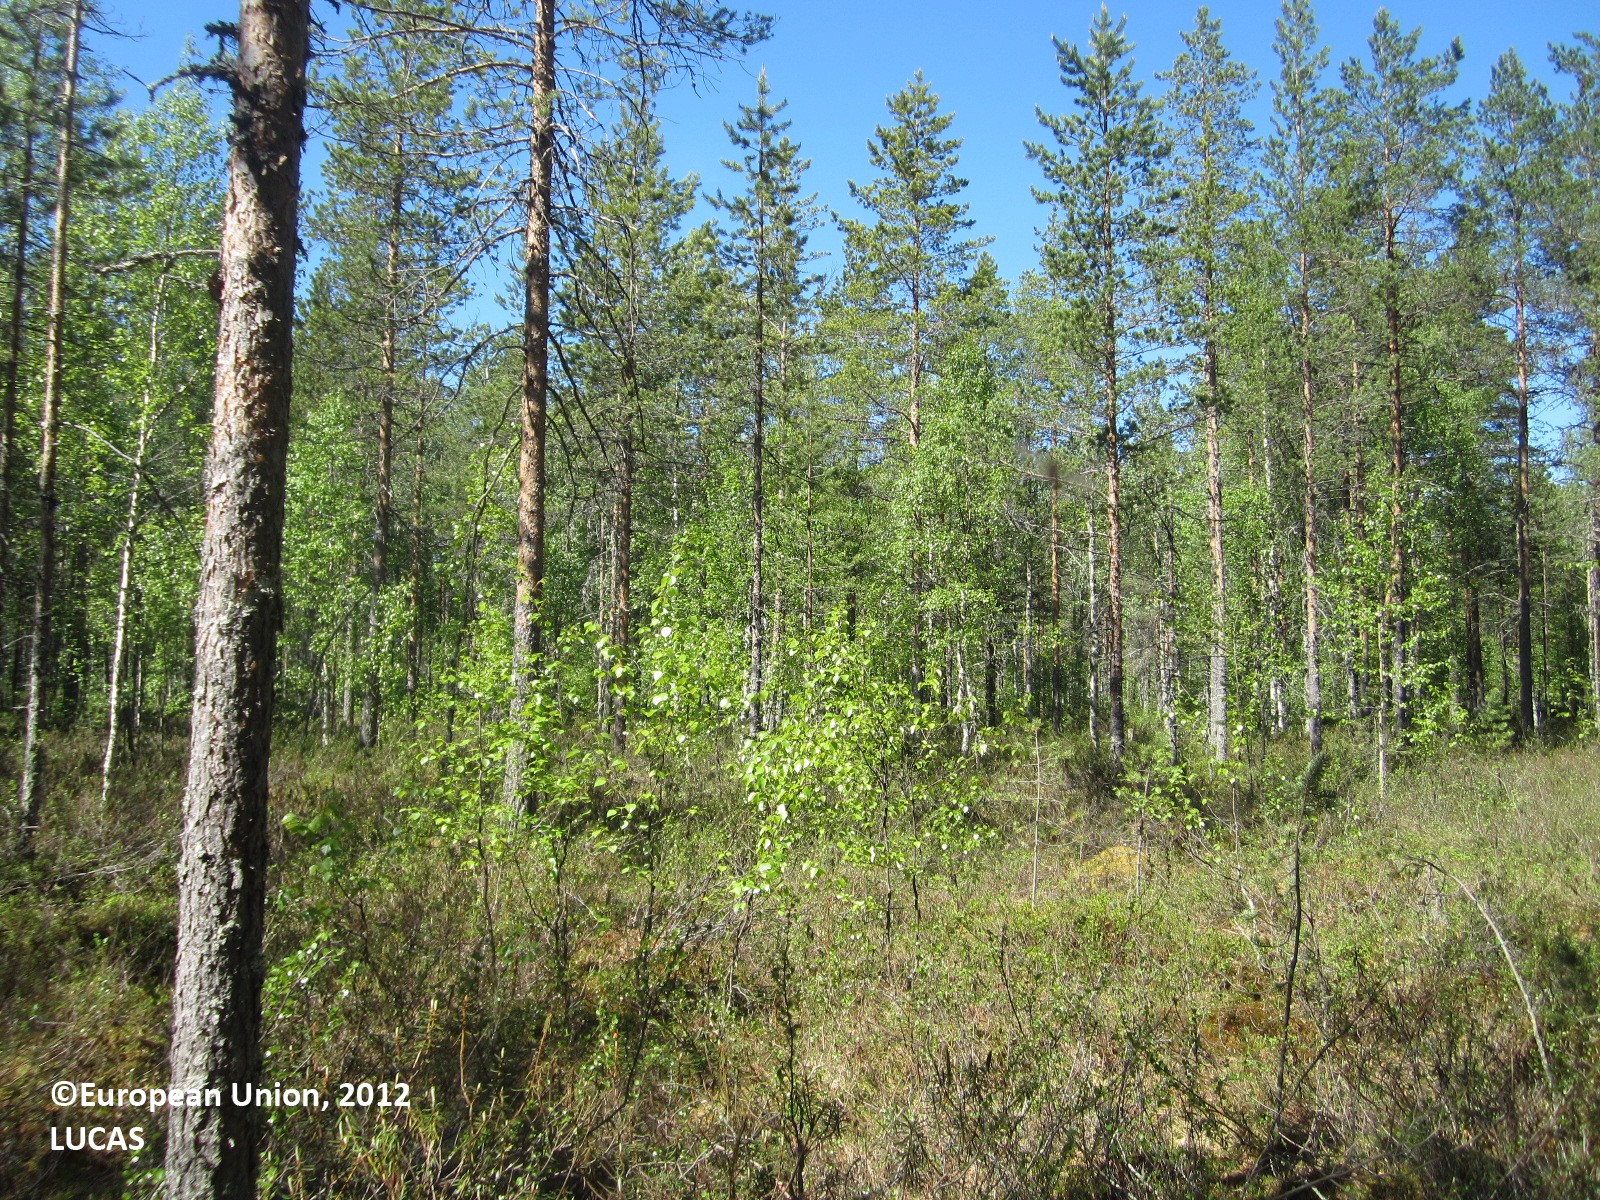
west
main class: Woodland
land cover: Pine dominated mixed woodland
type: boreal forest
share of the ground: 50 - 75 %
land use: Forestry
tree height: > 5 m
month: June
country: FI
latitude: 64.9034
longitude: 28.7967
